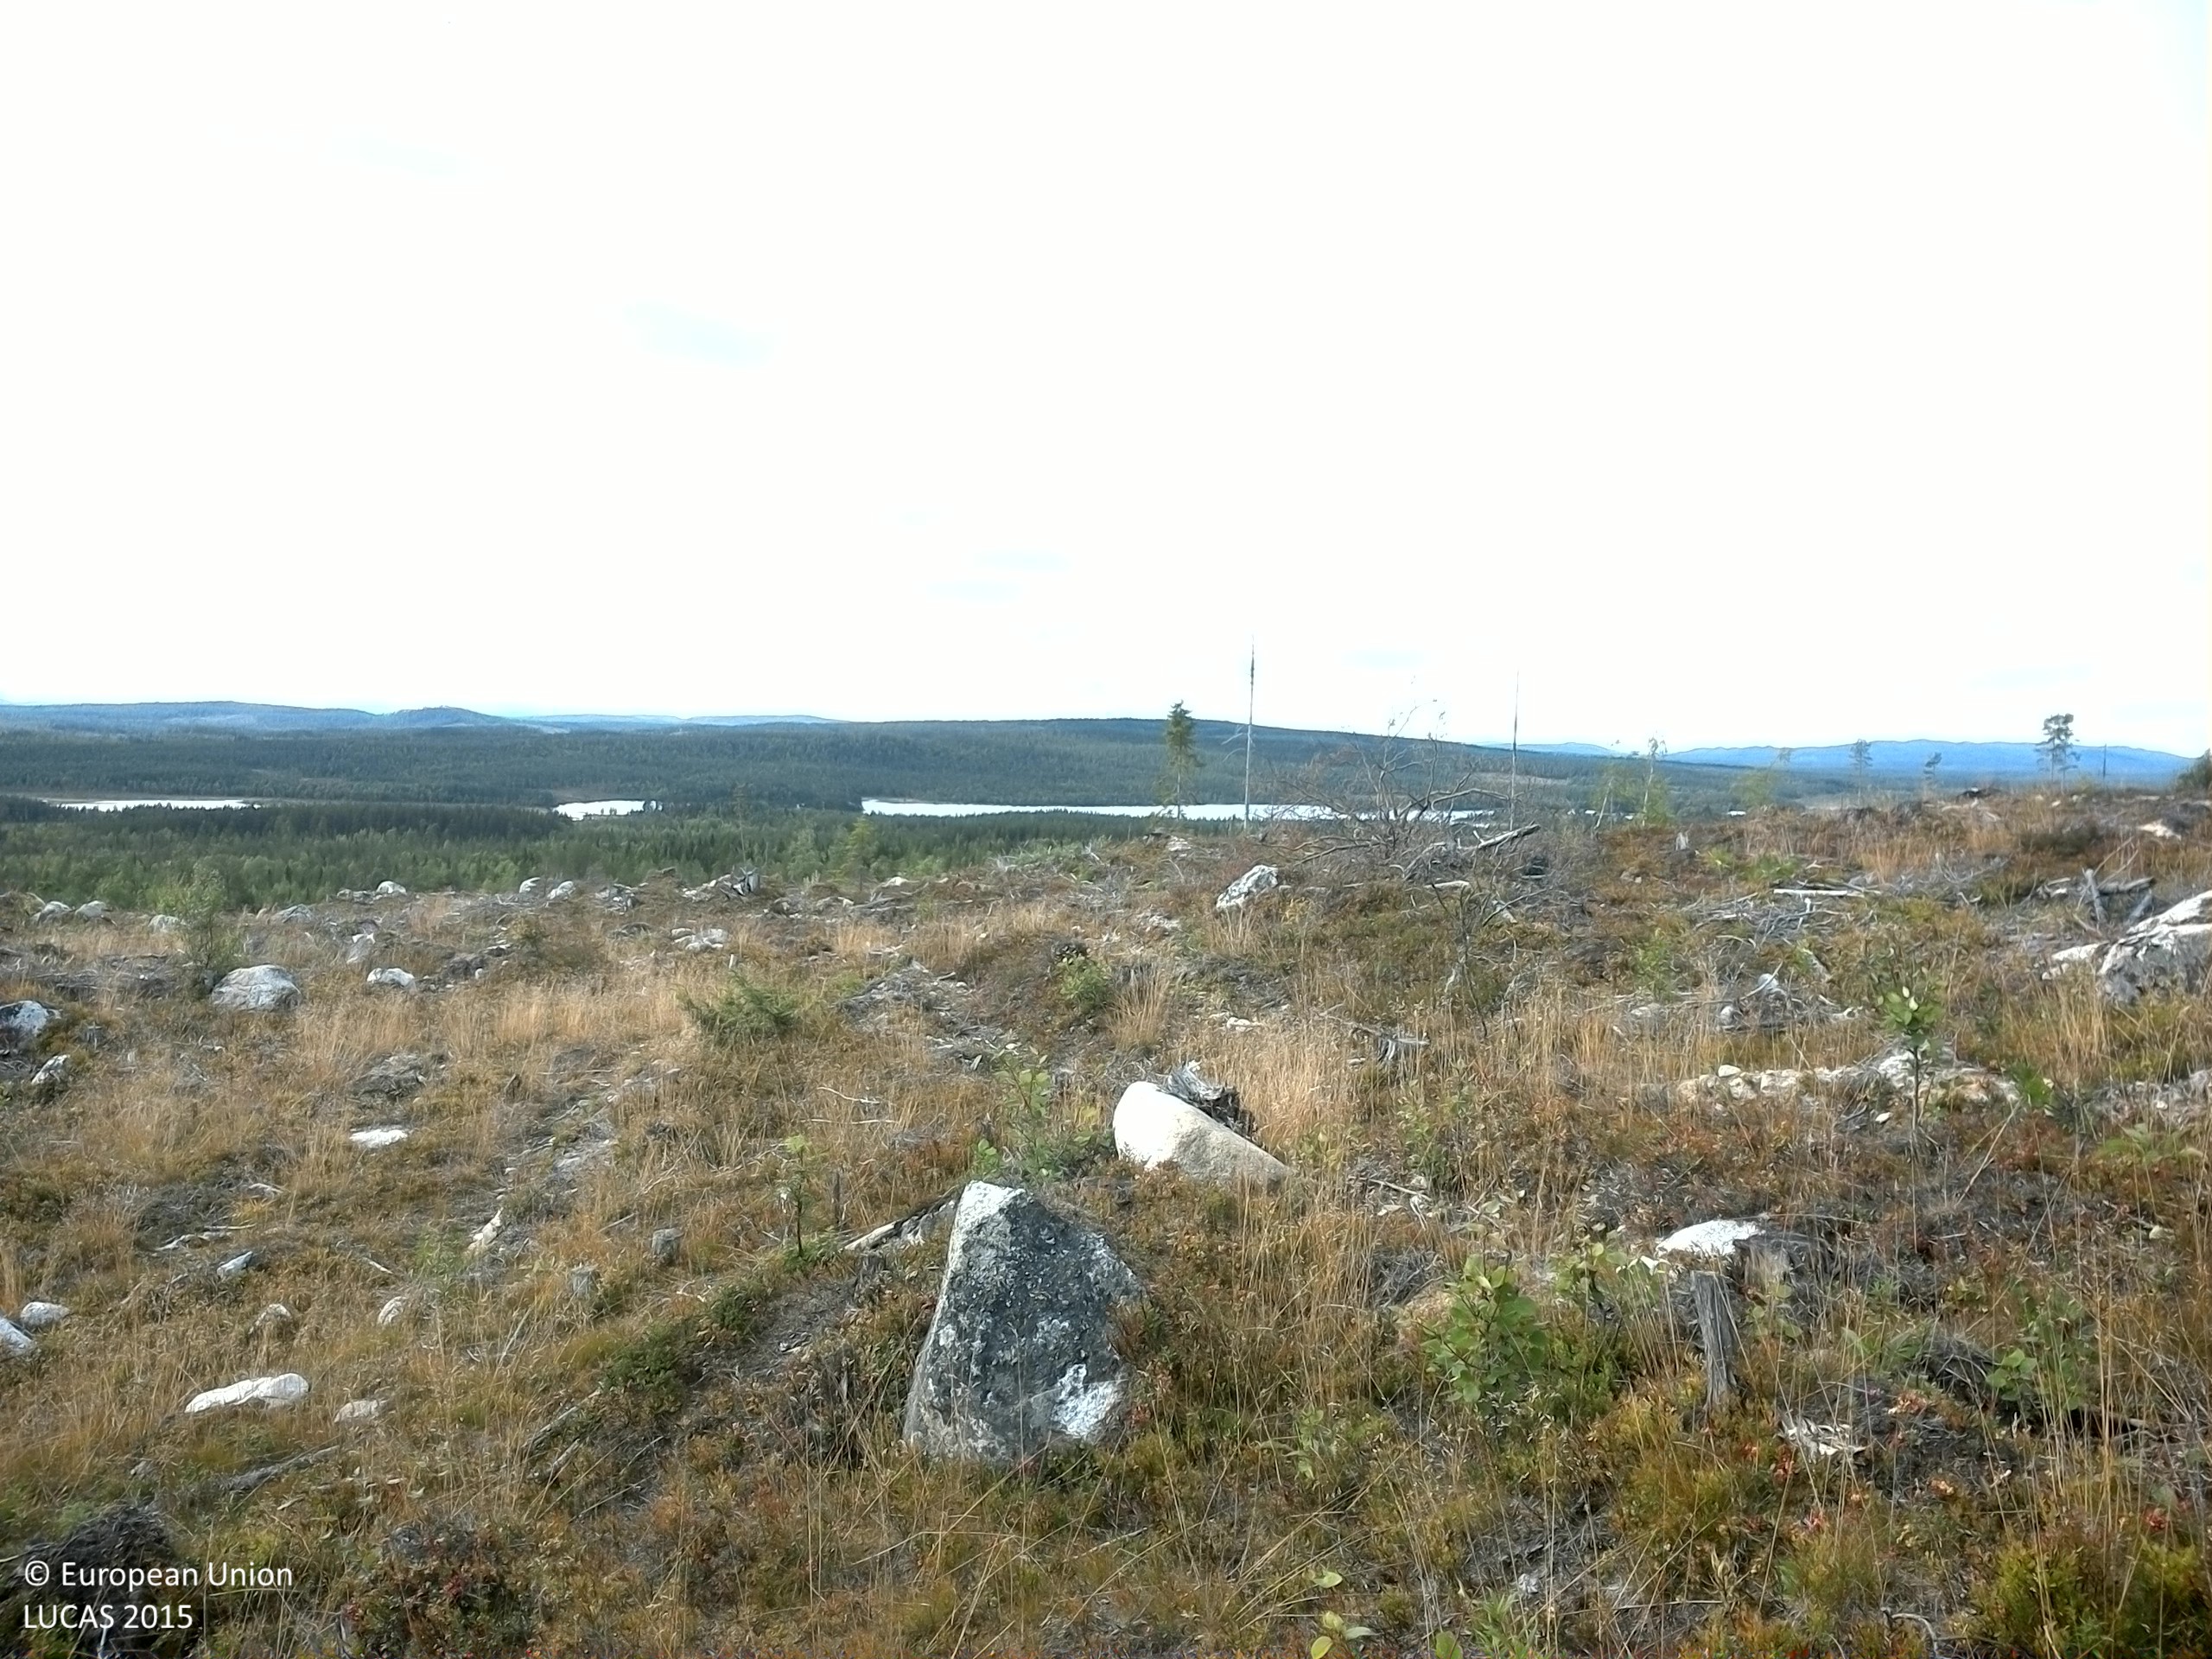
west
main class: Shrubland
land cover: Shrubland with sparse tree cover
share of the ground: 50 - 75 %
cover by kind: shrubs 60 %, herbaceous plants 20 %, lichens and mosses 10 %, broadleaved forest trees 5 %, unconsolidated bare surface 5 %
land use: Forestry
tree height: < 5 m
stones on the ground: > 50 %
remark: Clear cut
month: September
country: SE
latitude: 64.1655
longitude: 17.5178
